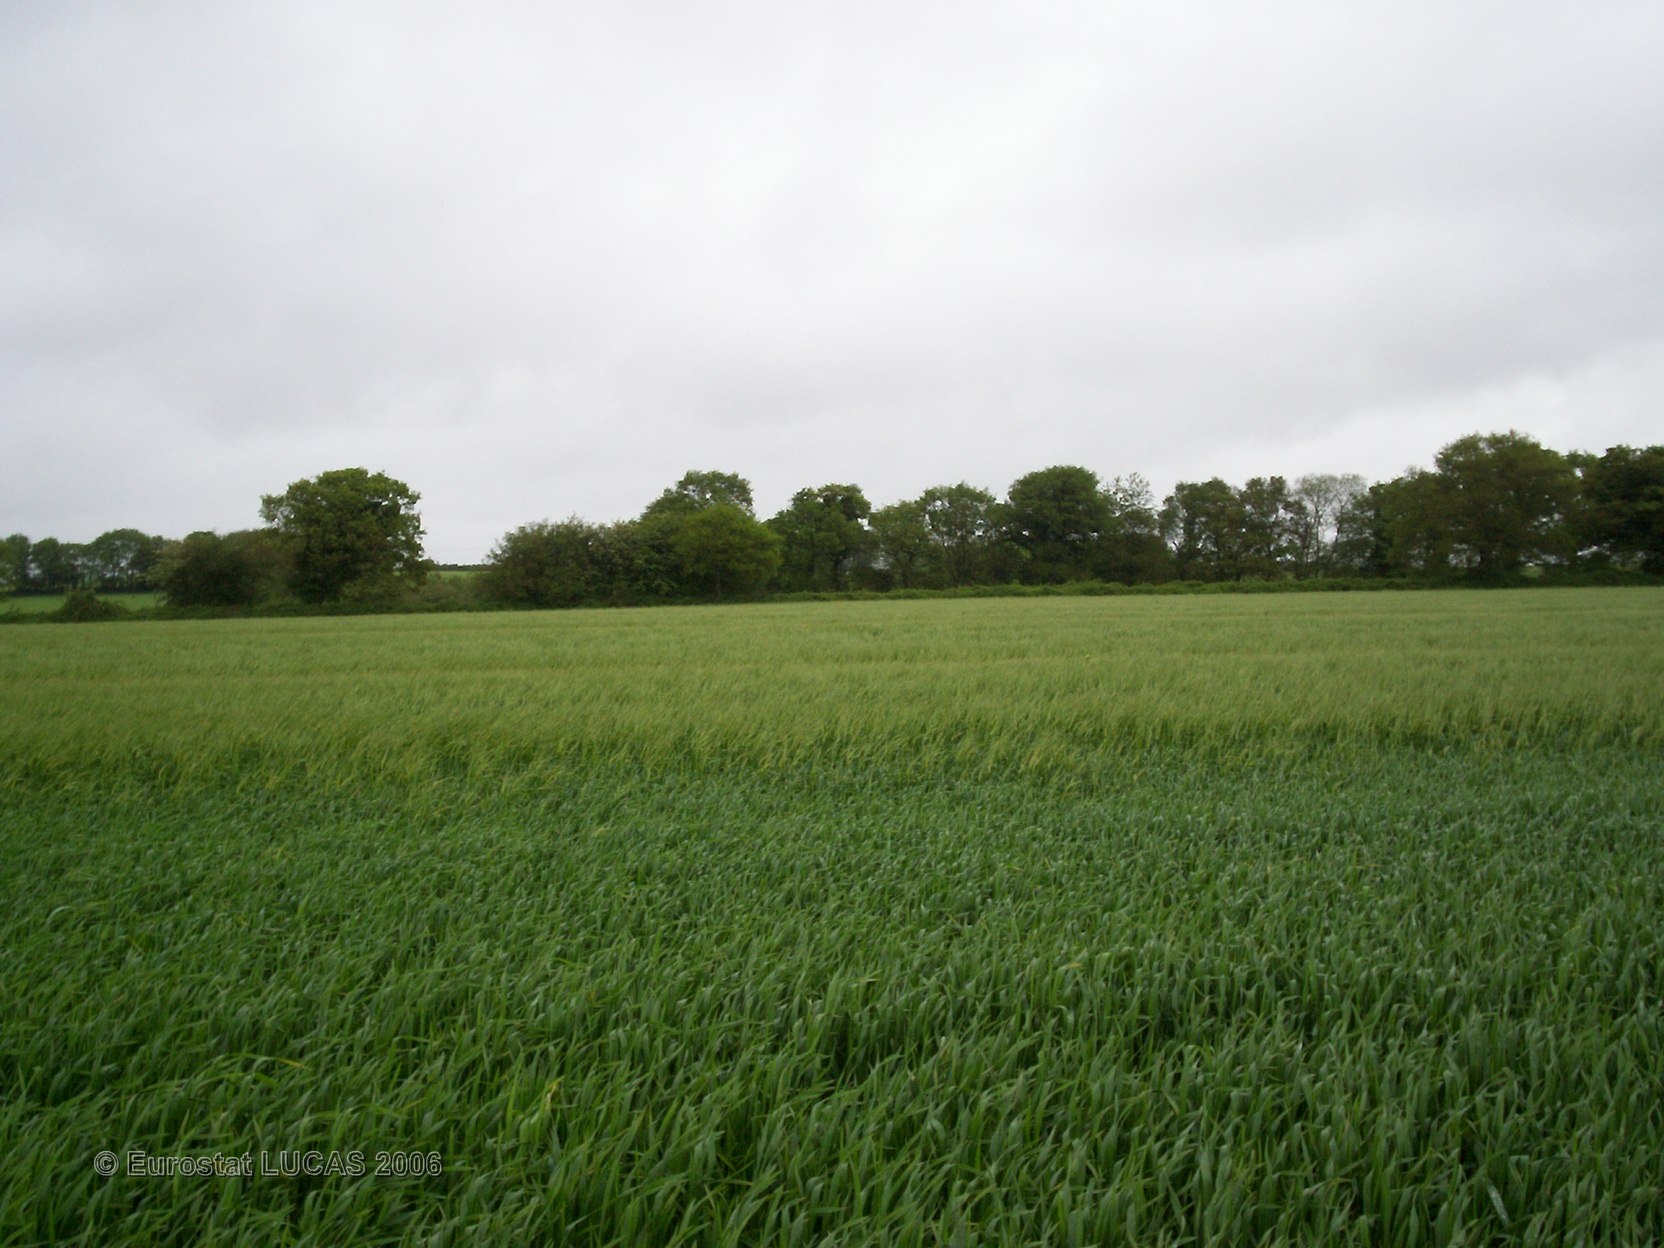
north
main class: Cropland
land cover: Common wheat
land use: Agriculture (excluding fallow land and kitchen gardens)
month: May
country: FR
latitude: 48.3203
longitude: -3.6343
